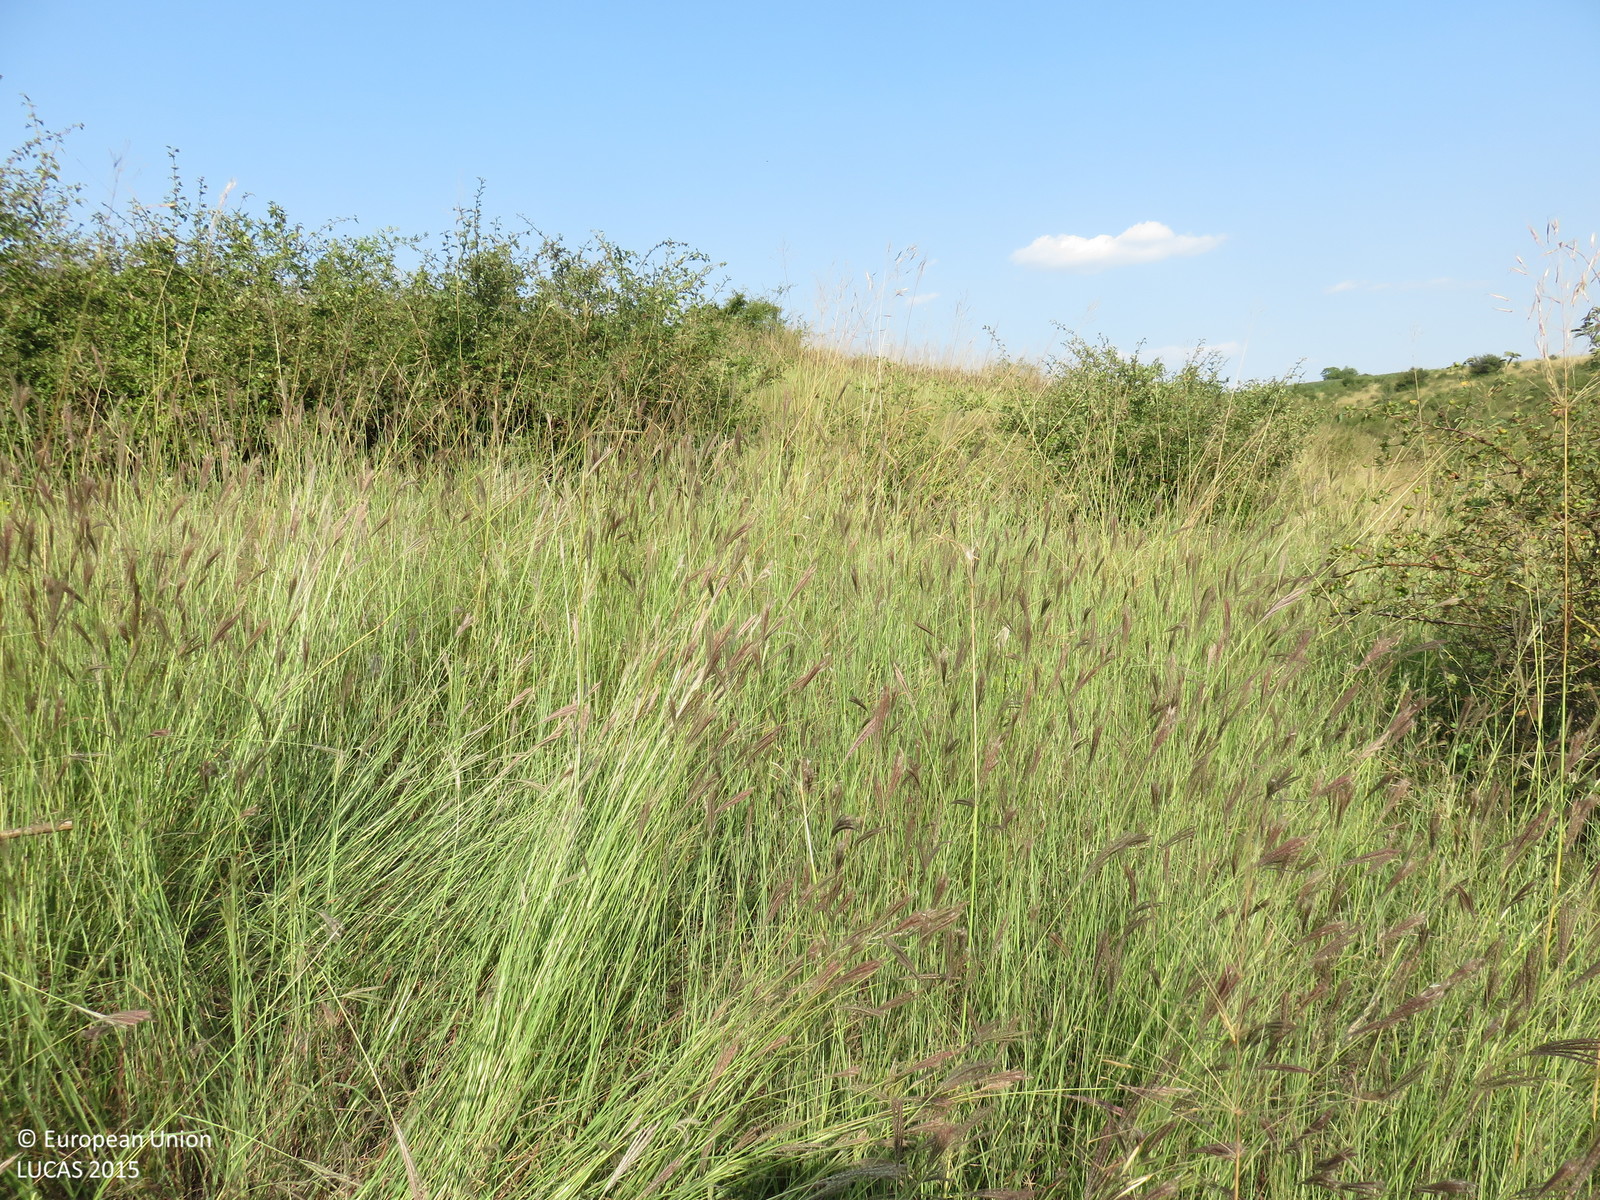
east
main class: Grassland
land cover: Grassland with sparse tree/shrub cover
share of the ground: > 75 %
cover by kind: herbaceous plants 90 %, broadleaved forest trees 5 %, shrubs 5 %
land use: Agriculture (excluding fallow land and kitchen gardens)
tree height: < 5 m
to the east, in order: Grassland with sparse tree/shrub cover; Grassland without tree/shrub cover
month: July
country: BG
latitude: 43.6010
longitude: 25.0000
